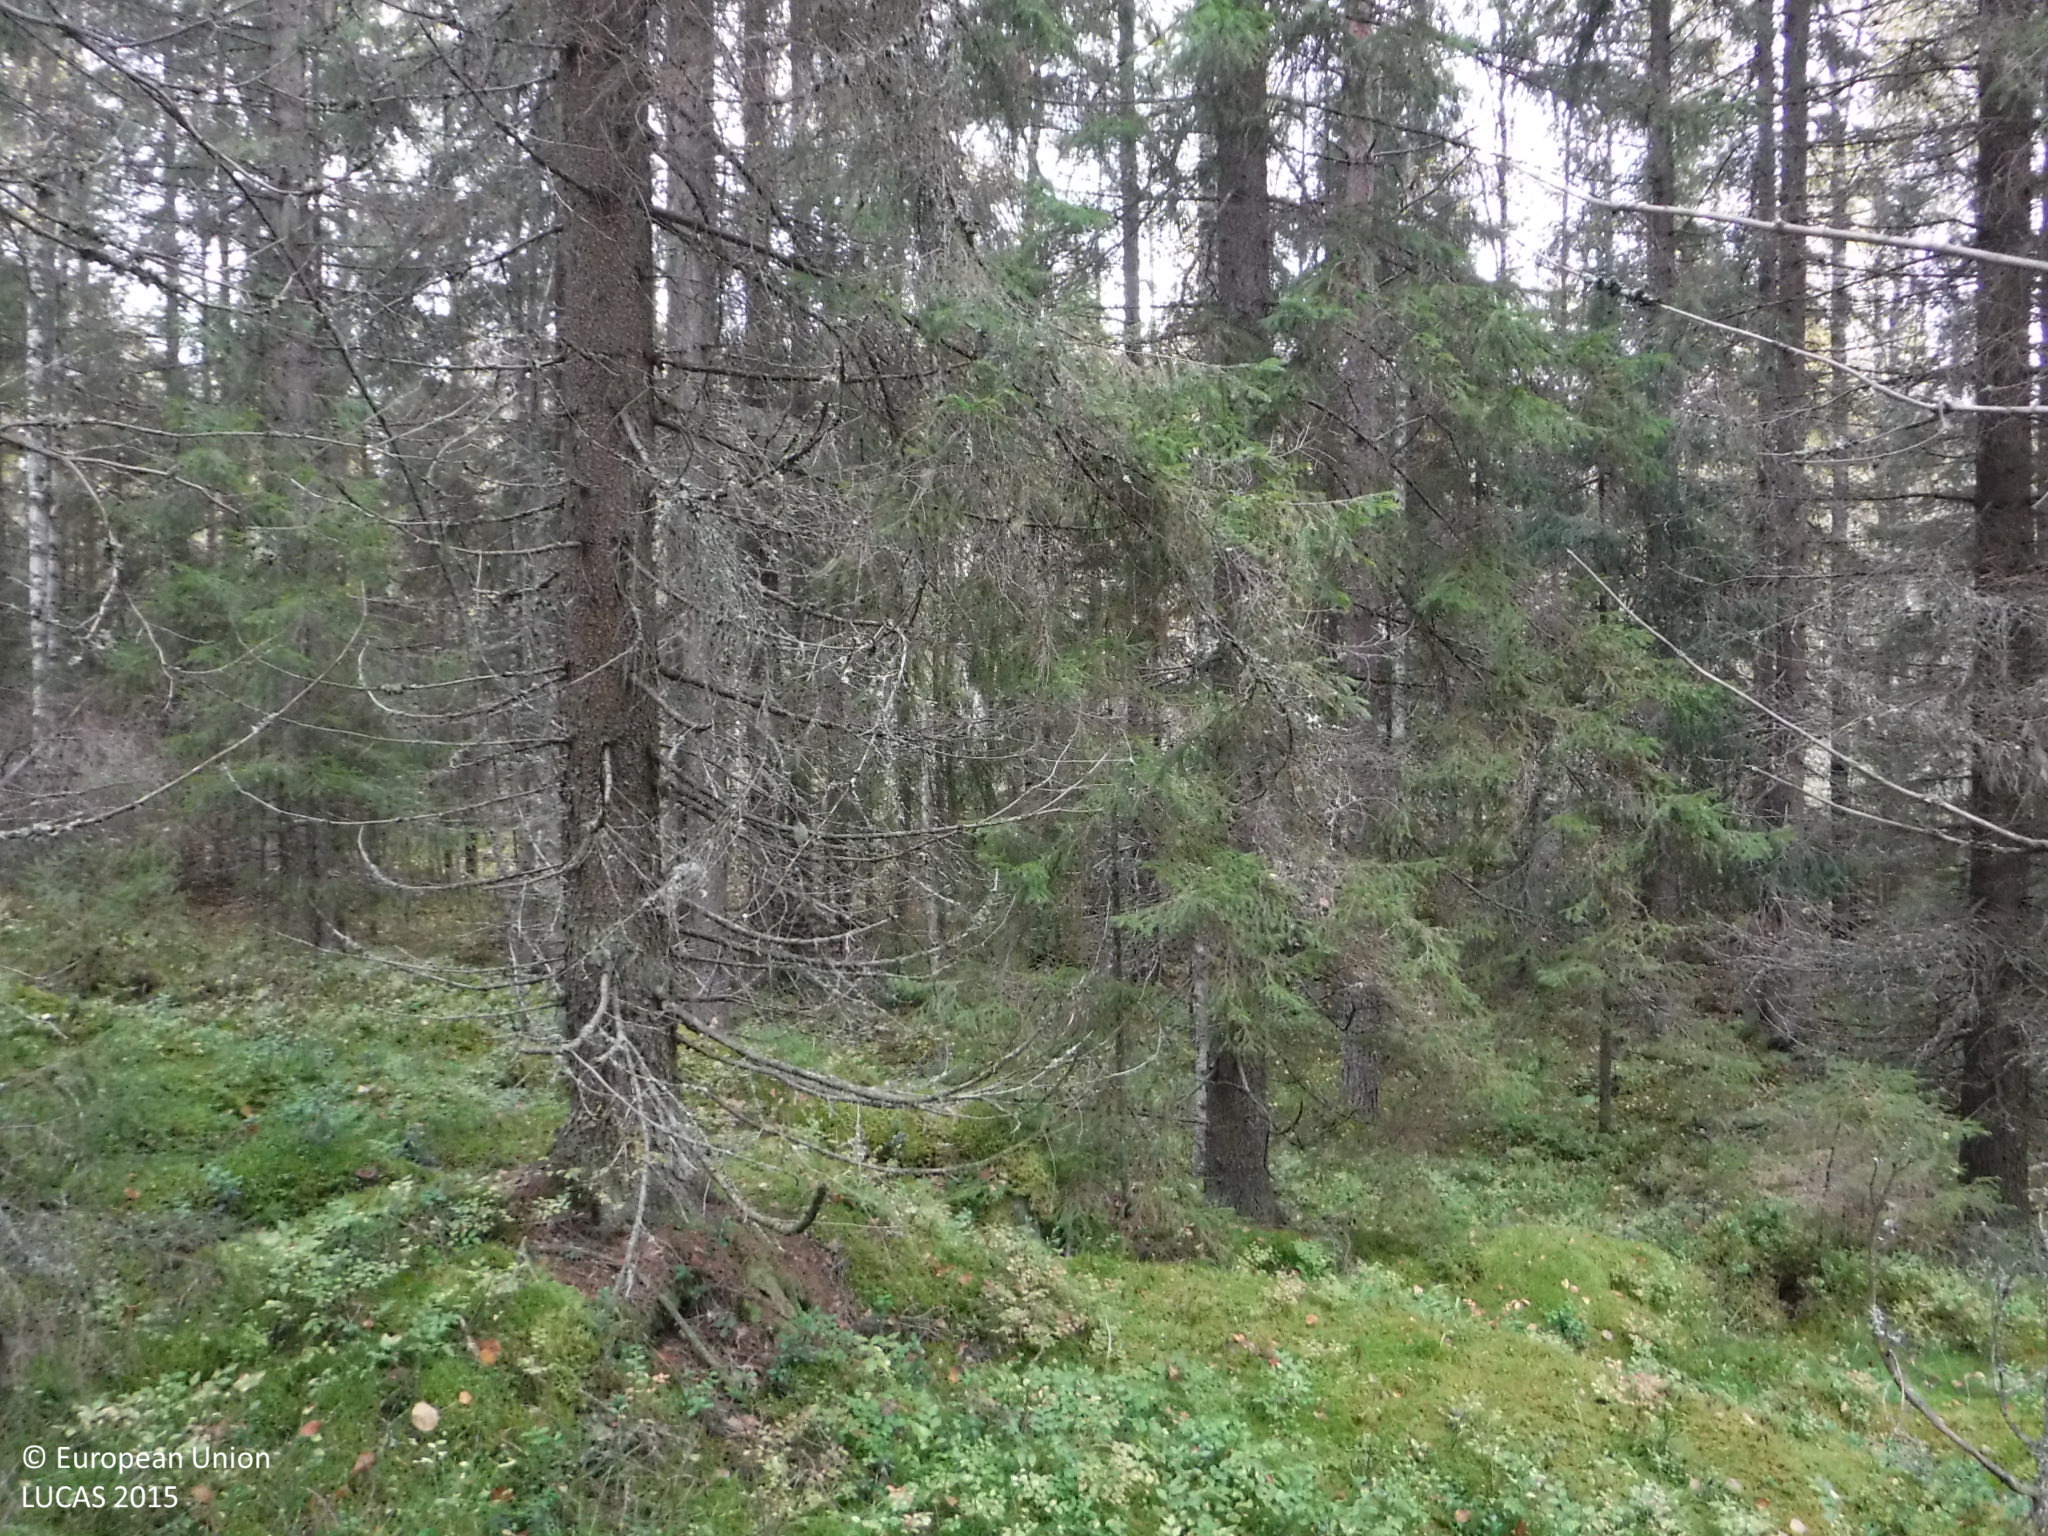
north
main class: Woodland
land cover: Spruce dominated coniferous woodland
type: boreal forest
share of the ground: 50 - 75 %
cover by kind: coniferous forest trees 60 %, lichens and mosses 30 %, shrubs 10 %
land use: Forestry
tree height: > 5 m
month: September
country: FI
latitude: 61.5963
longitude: 23.8992
